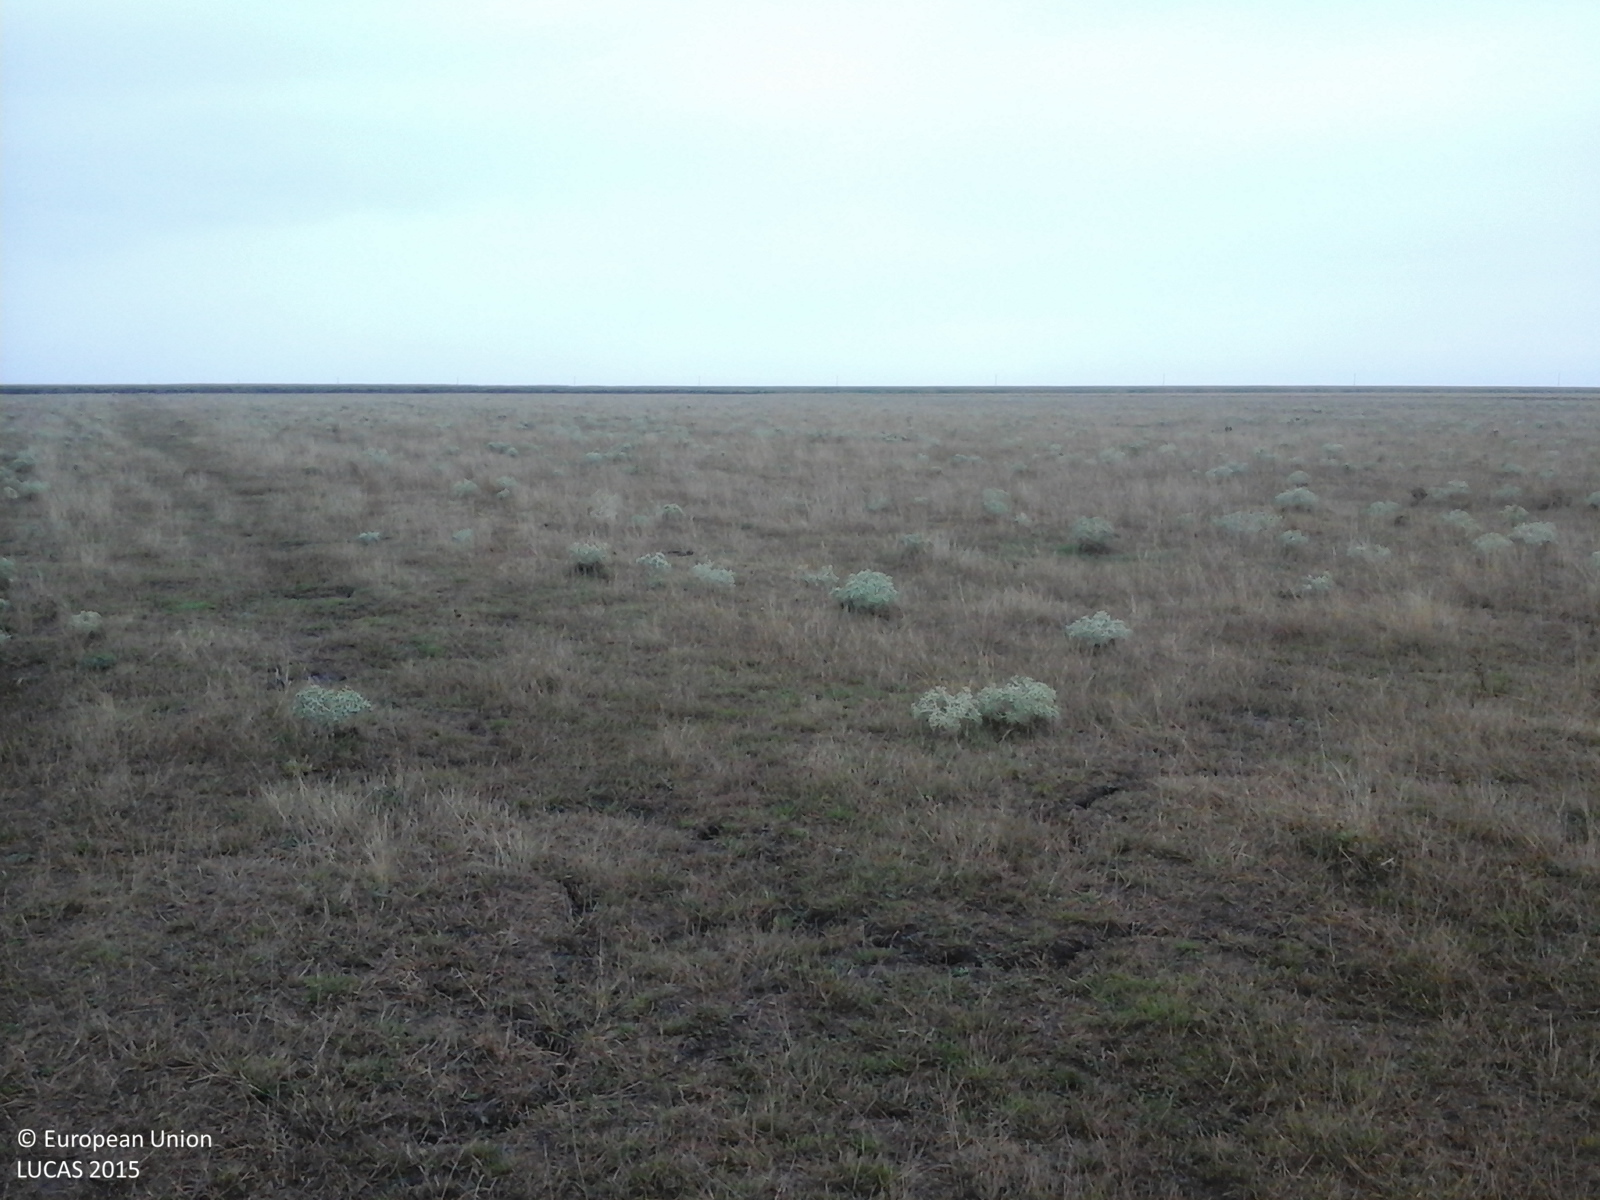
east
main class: Grassland
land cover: Spontaneously vegetated surfaces
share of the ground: > 75 %
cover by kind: herbaceous plants 100 %
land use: Fallow land
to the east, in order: Spontaneously vegetated surfaces
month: August
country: RO
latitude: 45.4639
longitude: 21.4266
